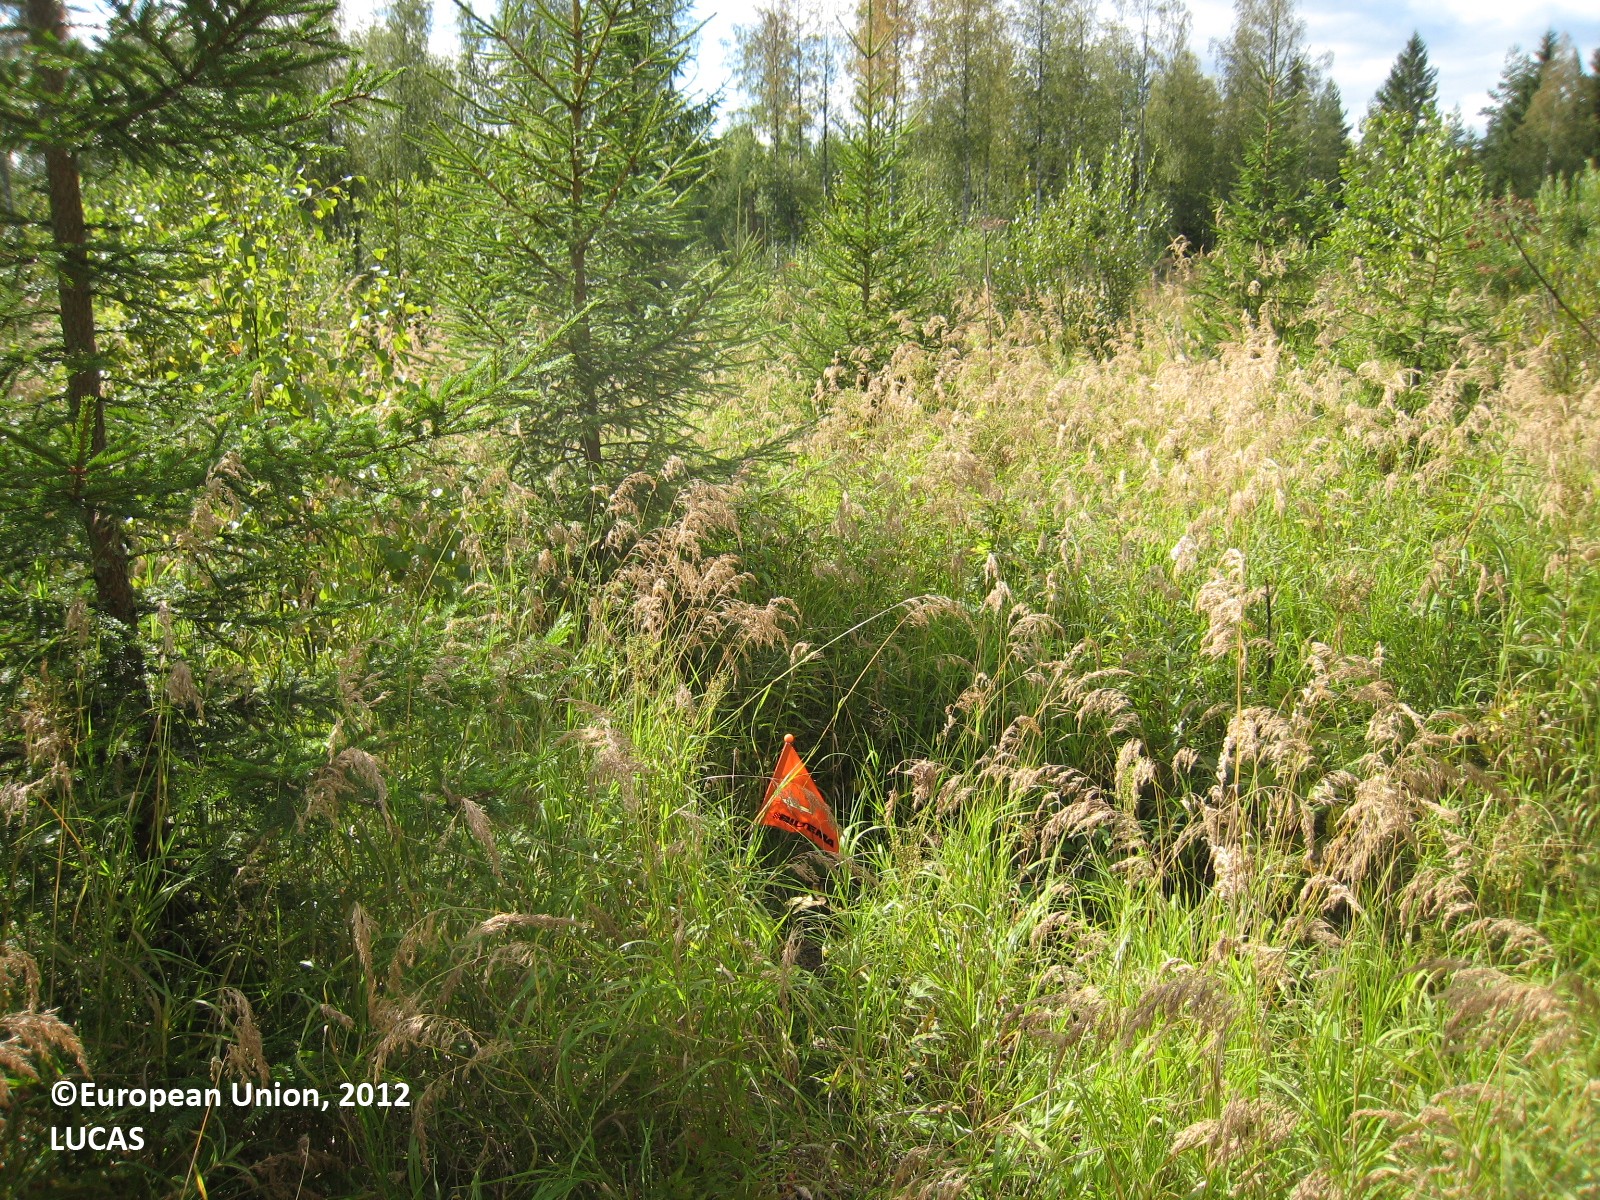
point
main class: Woodland
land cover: Spruce dominated mixed woodland
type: boreal forest
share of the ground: 50 - 75 %
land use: Forestry
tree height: < 5 m
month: August
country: FI
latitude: 61.9807
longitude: 27.2035
